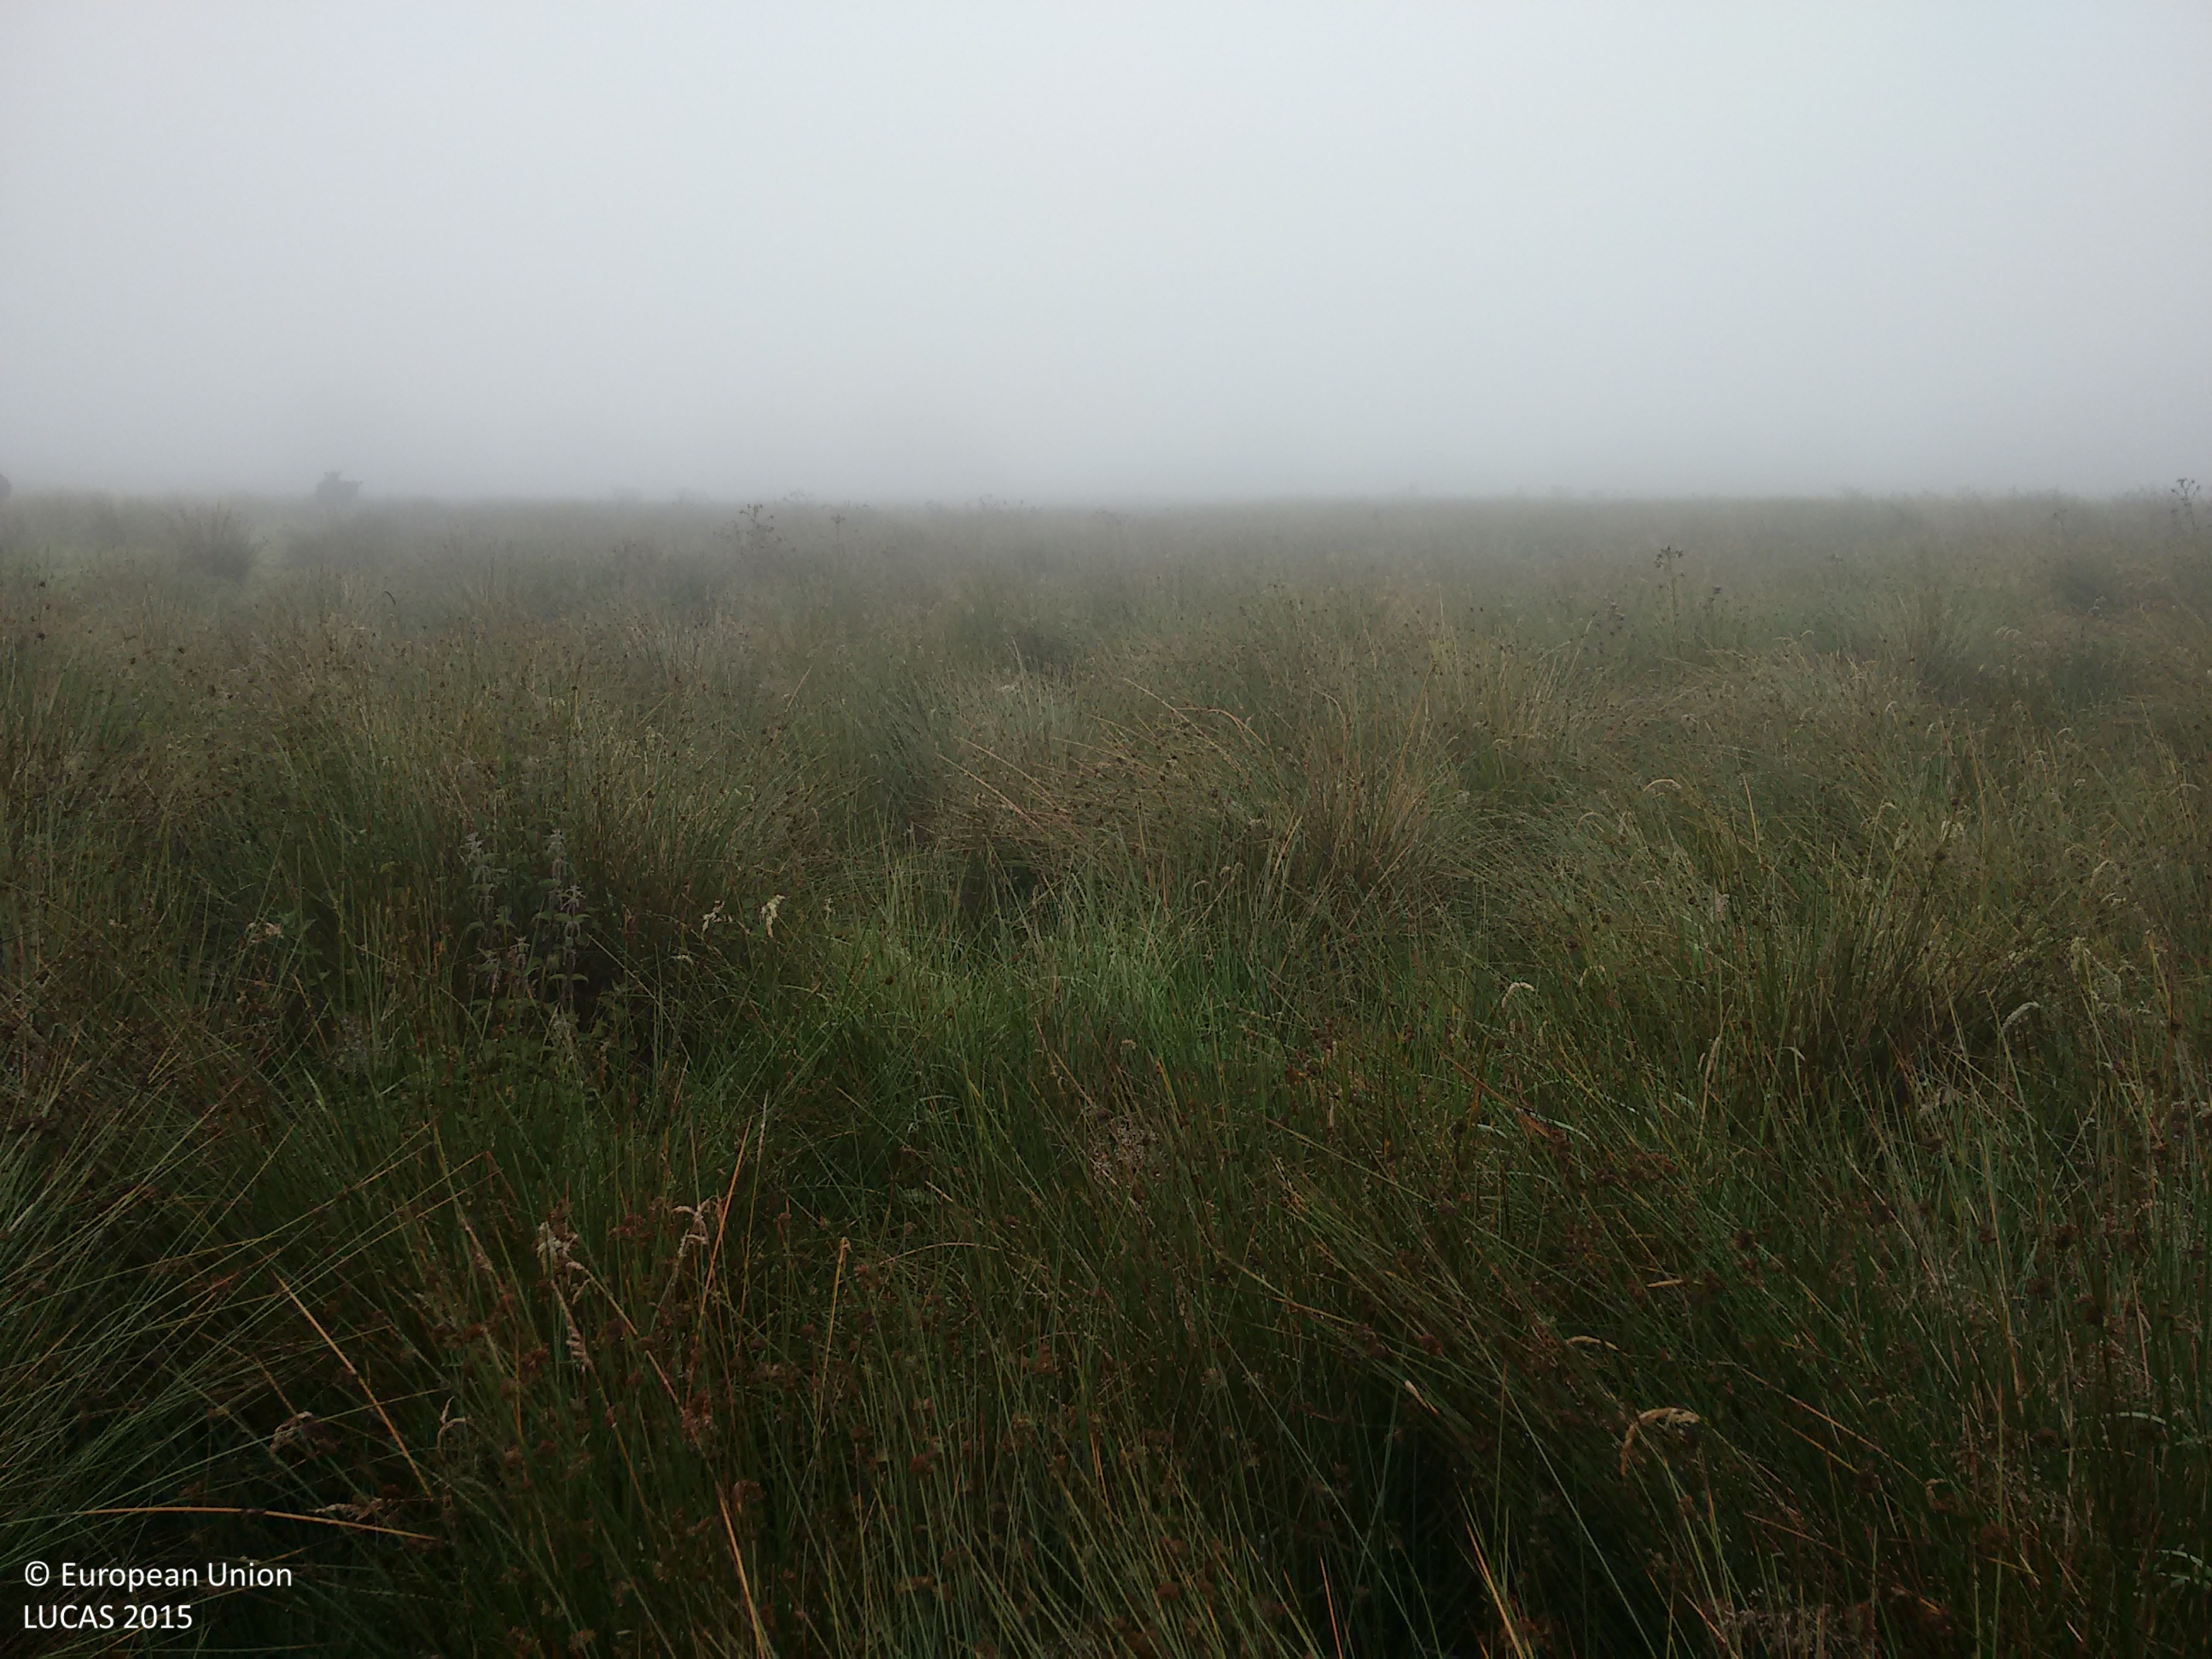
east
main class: Grassland
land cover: Grassland without tree/shrub cover
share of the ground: > 75 %
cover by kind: herbaceous plants 100 %
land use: Agriculture (excluding fallow land and kitchen gardens)
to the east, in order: Grassland without tree/shrub cover; Ditches and canals; Grassland without tree/shrub cover; Fences; Shruby margins; Inland fresh running water; Spontaneously vegetated surfaces; Ditches and canals; Spontaneously vegetated surfaces; Dry stone walls; Grass margins; Paved roads, cycling and walking lanes; Grassland without tree/shrub cover
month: August
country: GB
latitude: 50.5567
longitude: -3.9972
